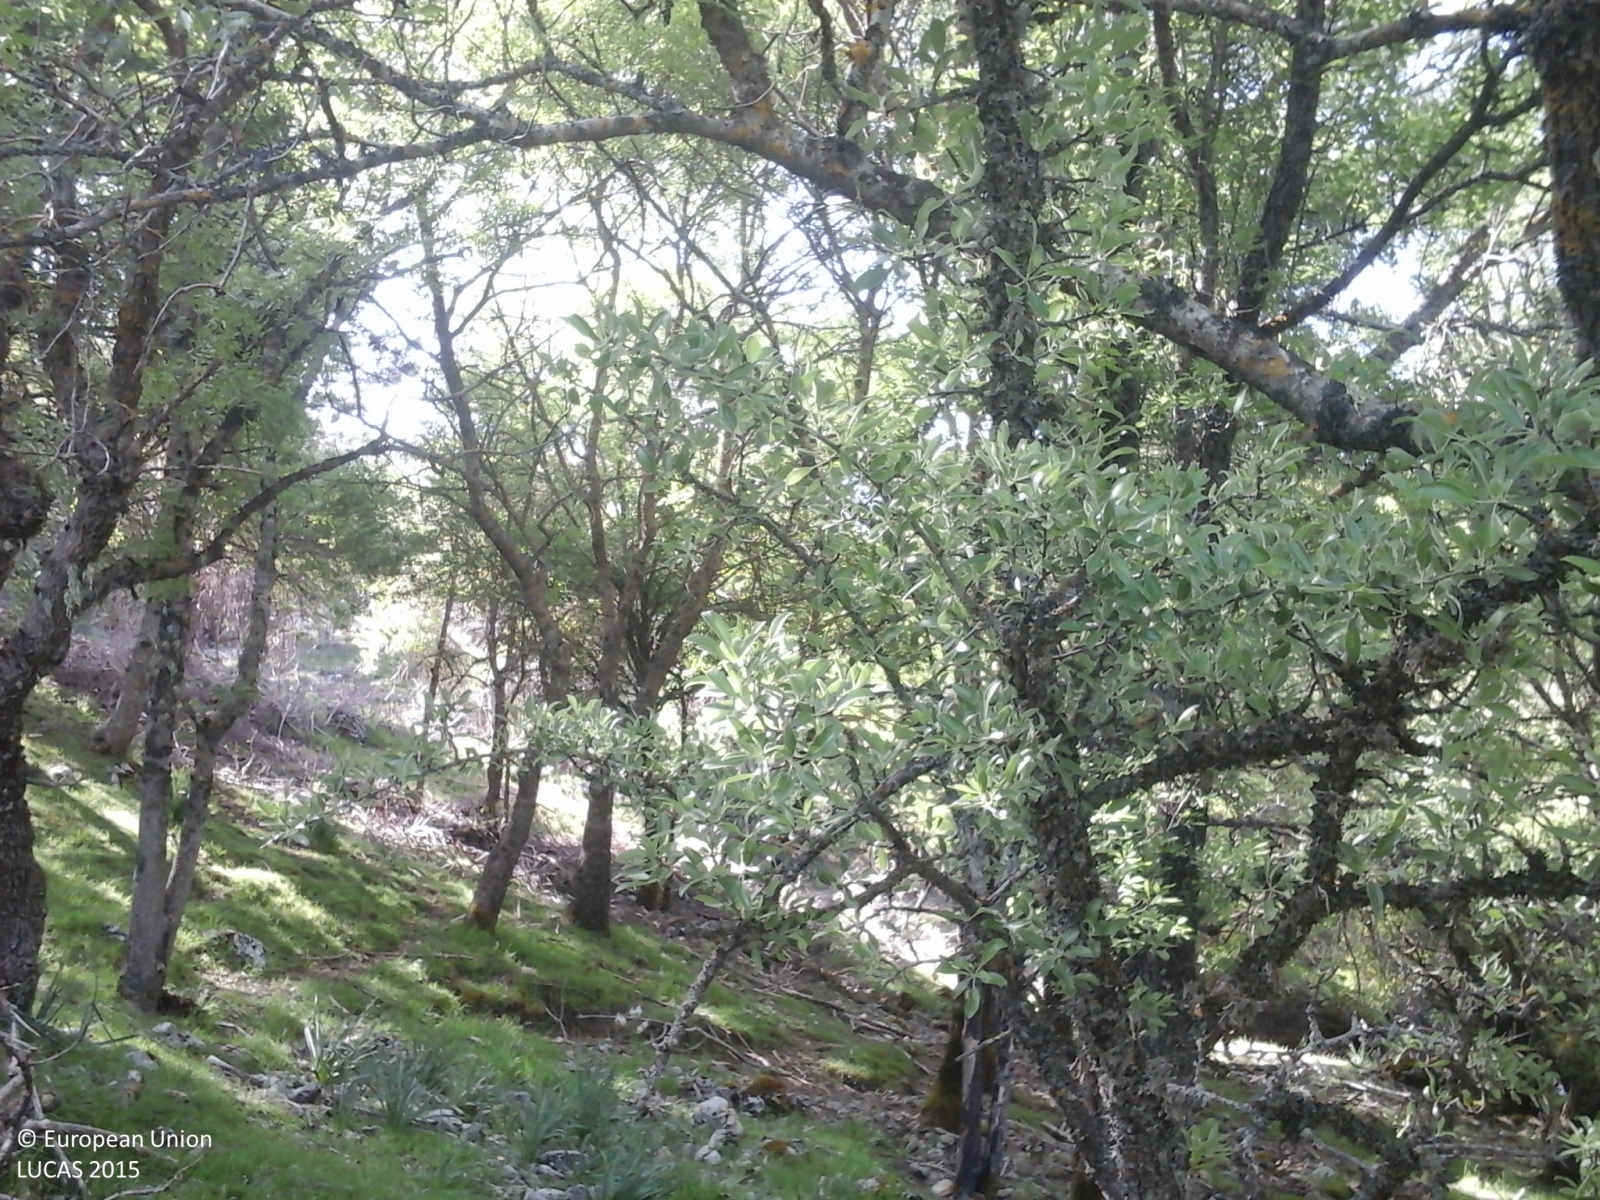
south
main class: Woodland
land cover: Broadleaved woodland
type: thermophilous deciduous forest
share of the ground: > 75 %
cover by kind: broadleaved forest trees 80 %, herbaceous plants 10 %, shrubs 5 %, consolidated bare surface 5 %
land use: Forestry
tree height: > 5 m
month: May
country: IT
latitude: 37.8811
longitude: 14.0078
